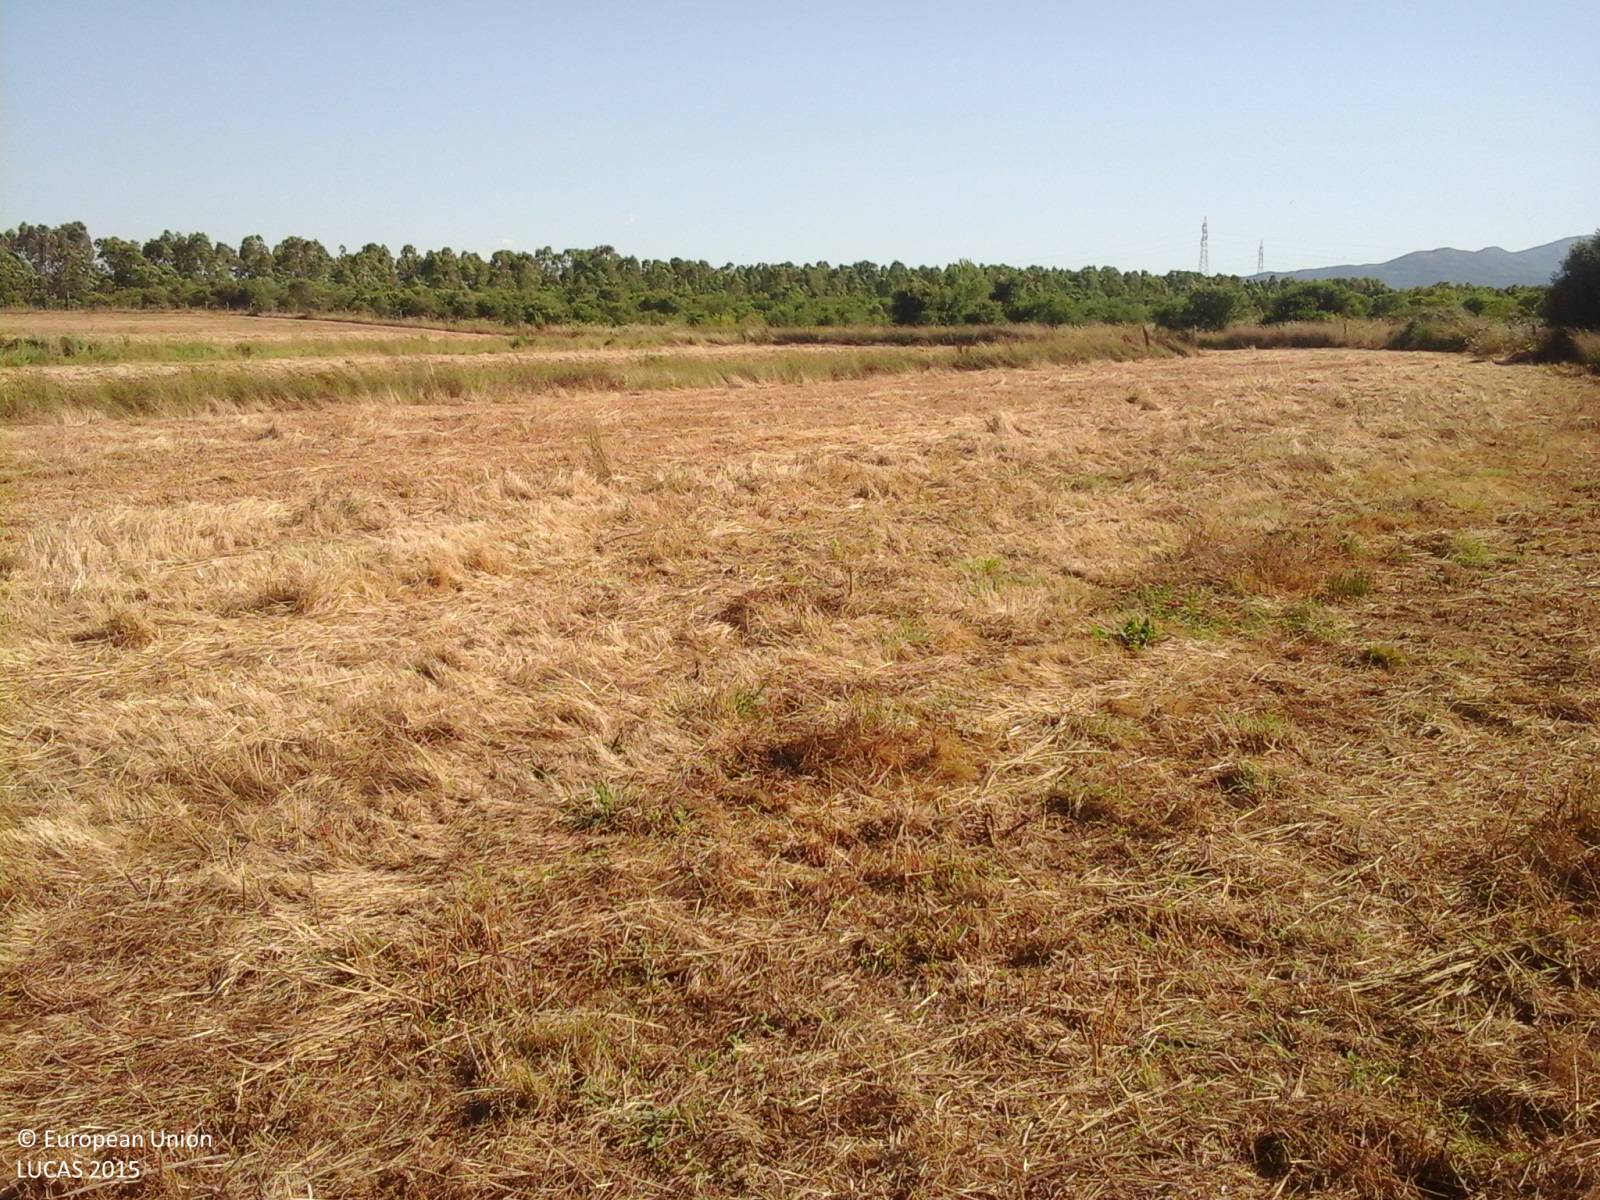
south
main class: Grassland
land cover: Grassland without tree/shrub cover
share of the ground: > 75 %
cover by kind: herbaceous plants 100 %
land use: Semi-natural and natural areas not in use
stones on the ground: 25 - 50 %
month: June
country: IT
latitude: 39.4810
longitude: 8.7865
